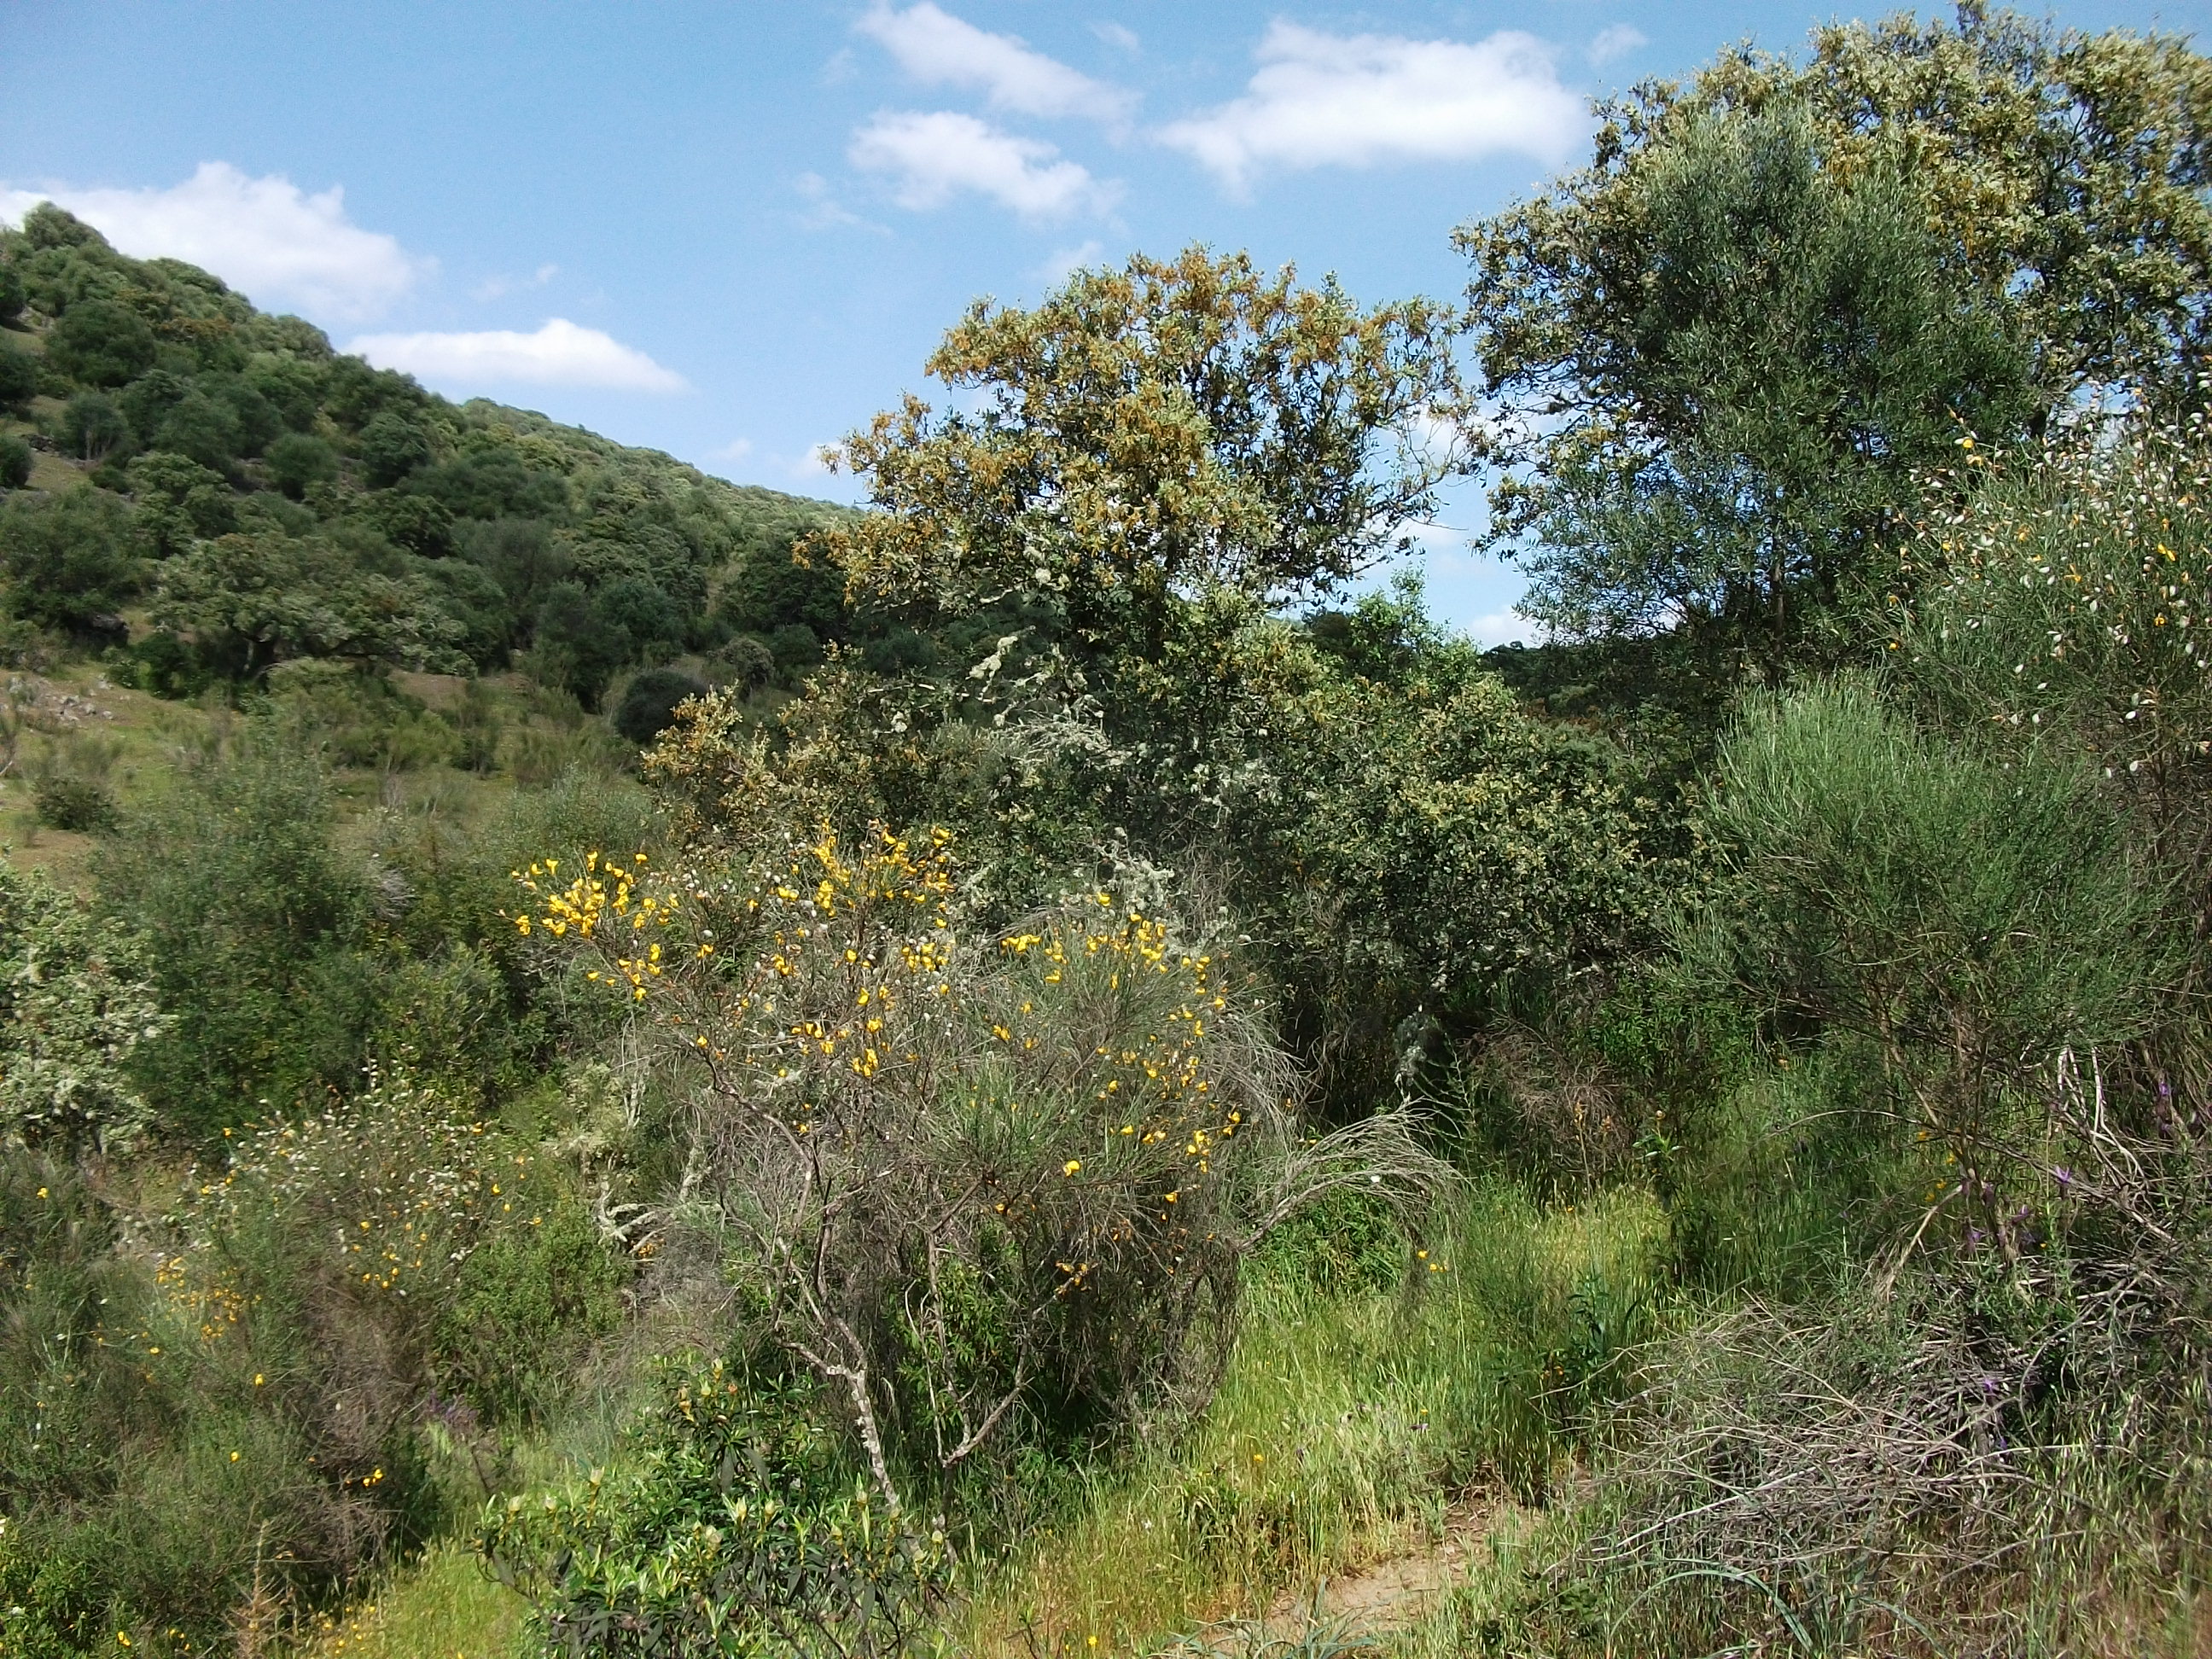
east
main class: Woodland
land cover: Broadleaved woodland
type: broadleaved evergreen forest
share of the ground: 25 - 50 %
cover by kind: shrubs 60 %, broadleaved forest trees 35 %, herbaceous plants 5 %
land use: Semi-natural and natural areas not in use
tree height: > 5 m
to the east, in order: Broadleaved woodland; Rock outcrops; Broadleaved woodland; Rock outcrops; Broadleaved woodland
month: April
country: ES
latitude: 38.0738
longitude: -6.7738
